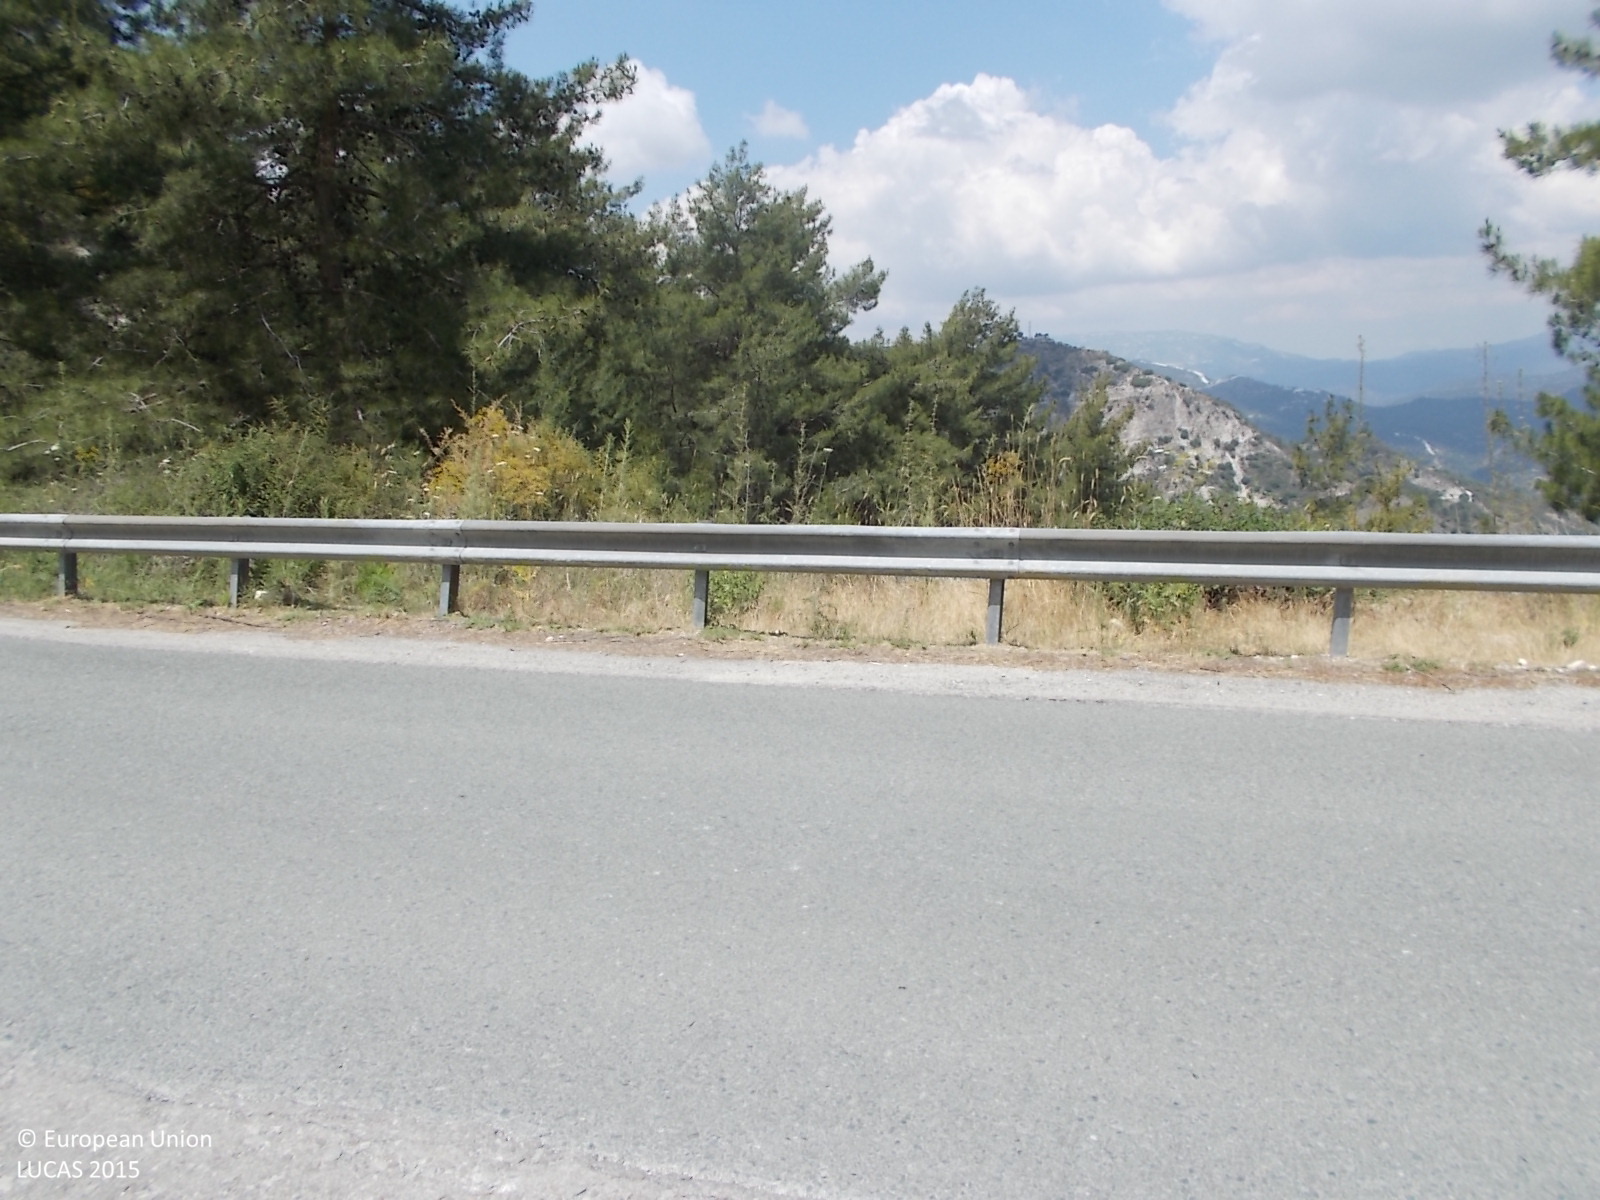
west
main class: Shrubland
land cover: Shrubland with sparse tree cover
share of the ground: > 75 %
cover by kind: shrubs 70 %, unconsolidated bare surface 15 %, consolidated bare surface 10 %, coniferous forest trees 5 %
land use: Semi-natural and natural areas not in use
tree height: > 5 m
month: June
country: CY
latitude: 34.8705
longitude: 32.7729
